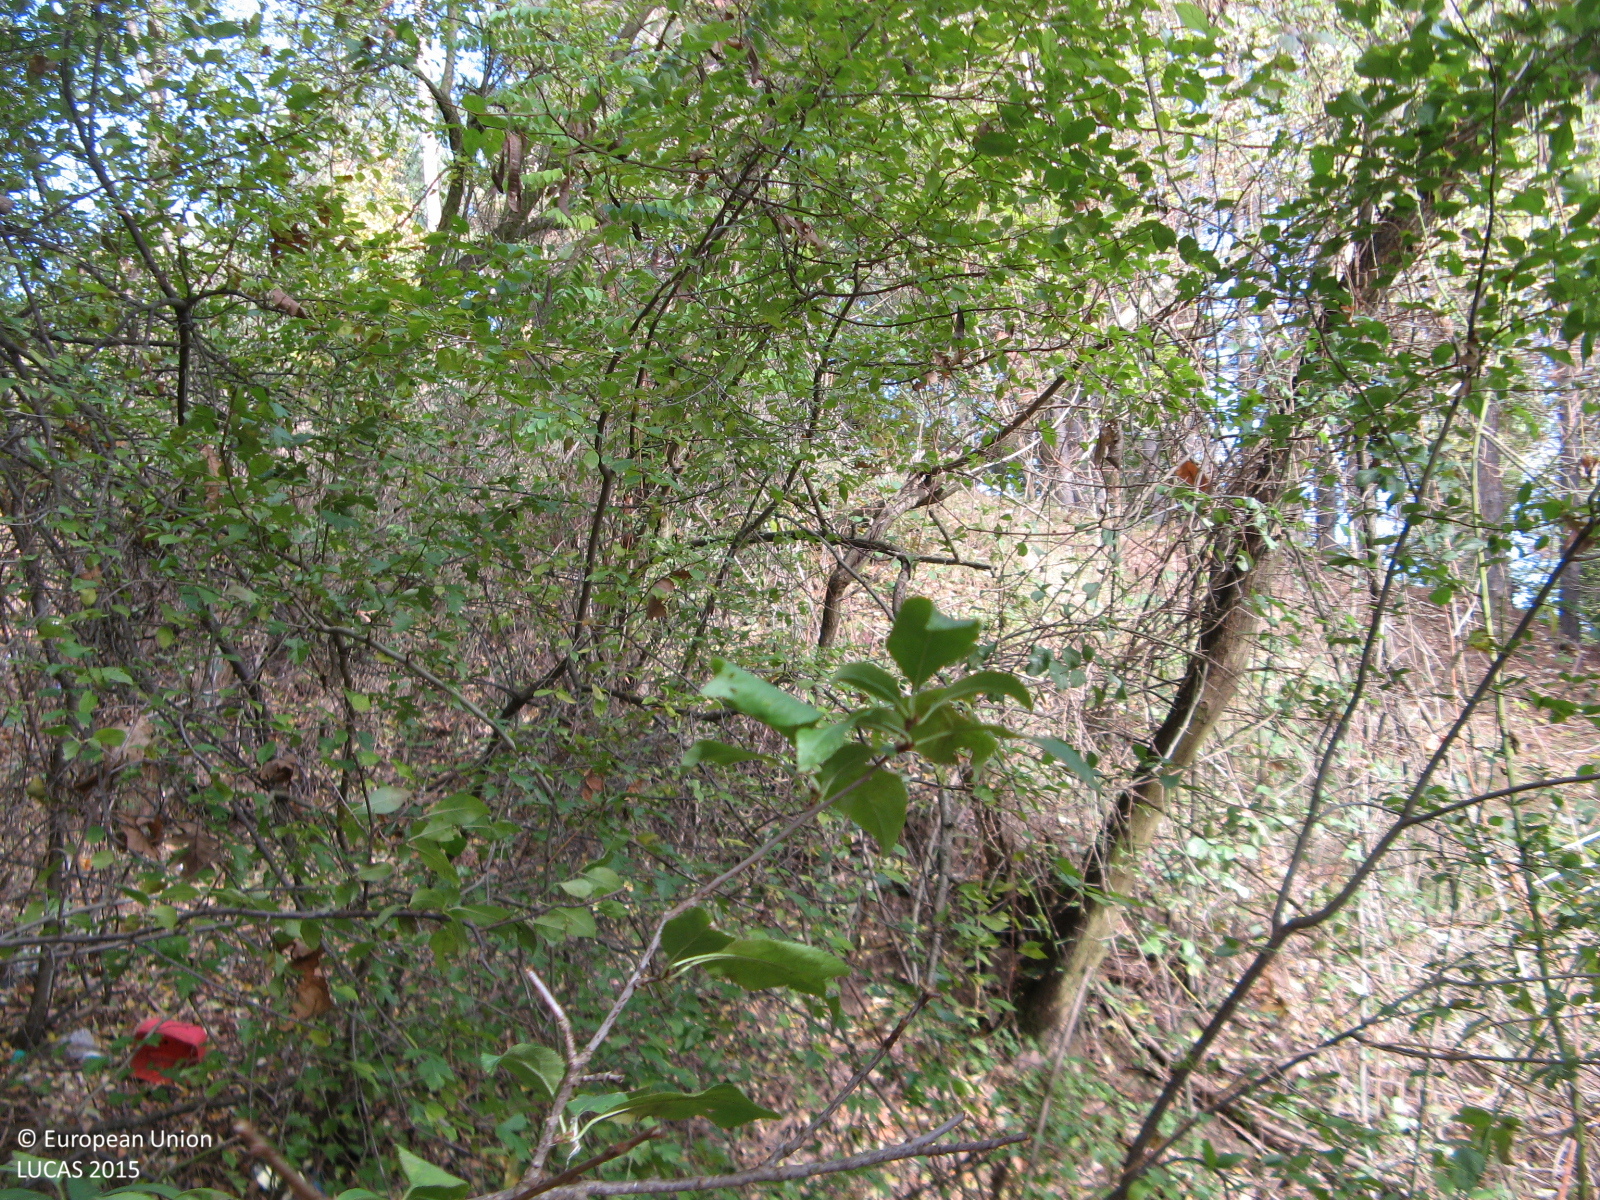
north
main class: Woodland
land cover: Broadleaved woodland
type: thermophilous deciduous forest
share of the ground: > 75 %
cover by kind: broadleaved forest trees 85 %, coniferous forest trees 5 %, shrubs 5 %, herbaceous plants 5 %
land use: Agriculture (excluding fallow land and kitchen gardens)
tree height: > 5 m
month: November
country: BG
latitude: 41.4941
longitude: 25.3510
